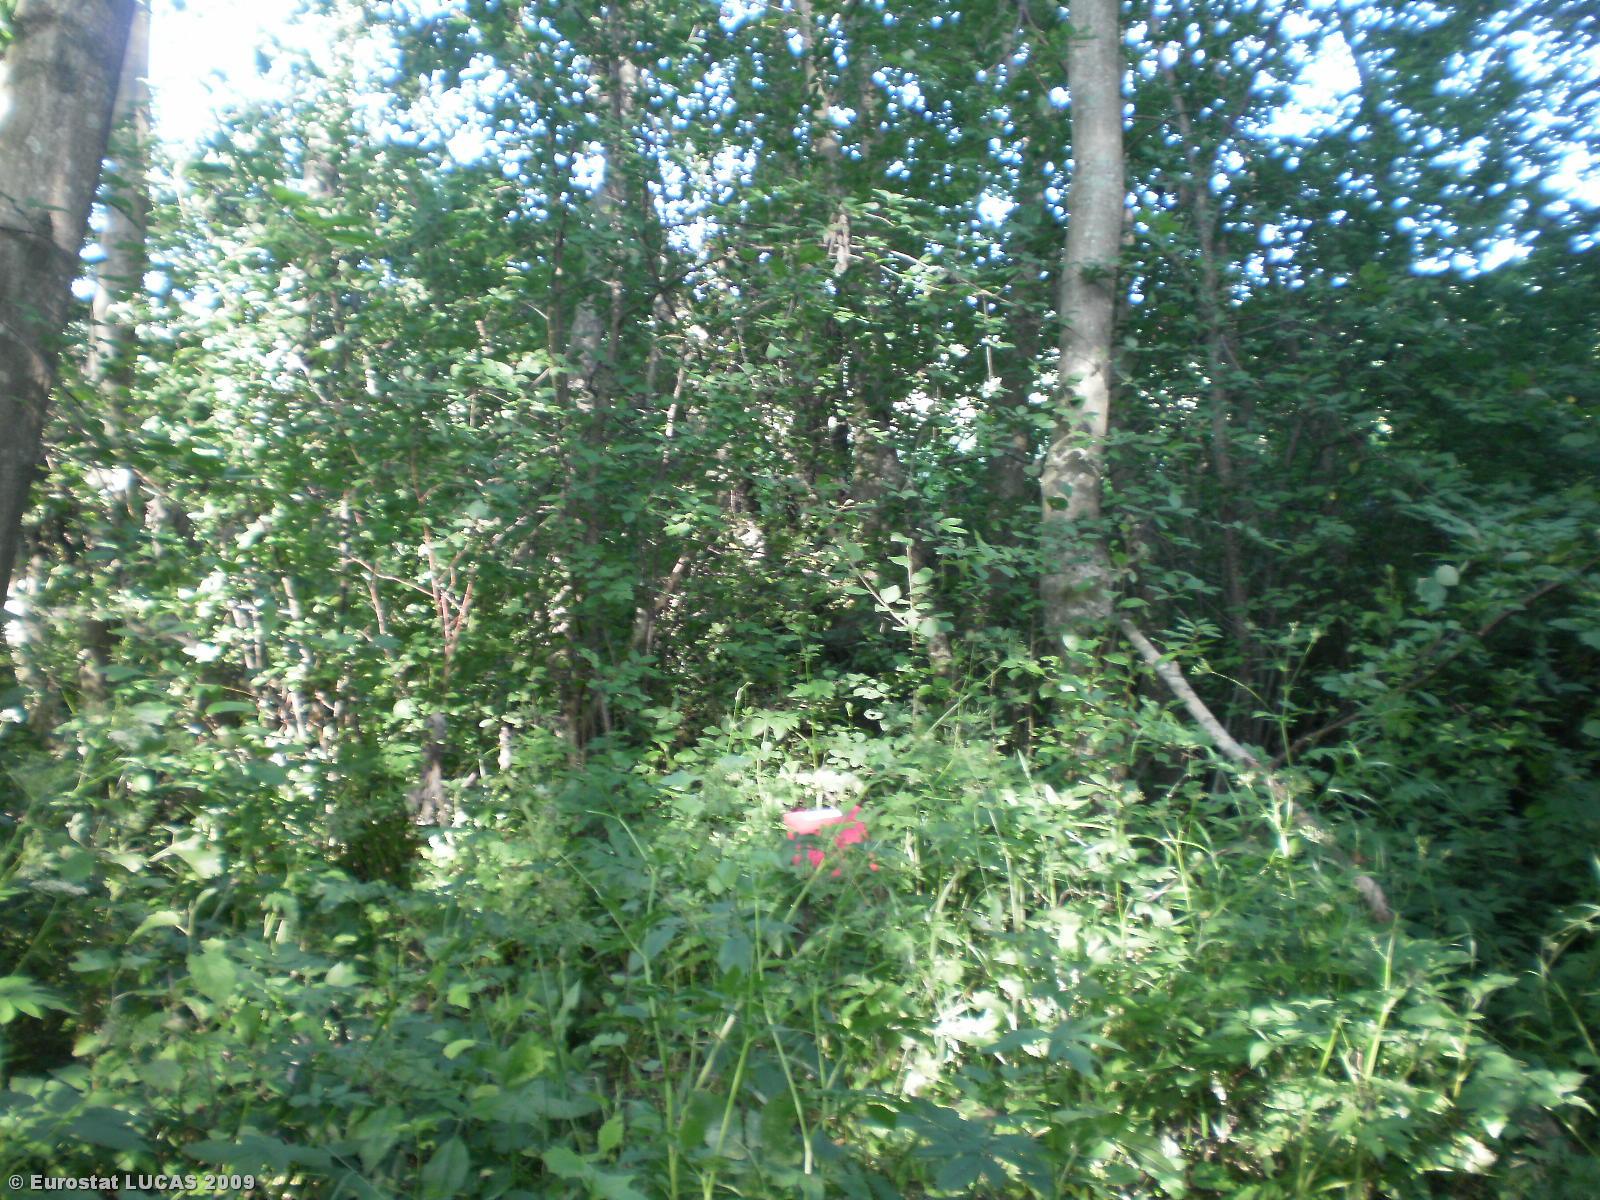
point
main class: Woodland
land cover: Broadleaved woodland
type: non-riverine alder, birch or aspen forest
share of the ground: > 75 %
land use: Forestry
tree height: > 5 m
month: July
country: LT
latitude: 55.9689
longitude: 25.8163
